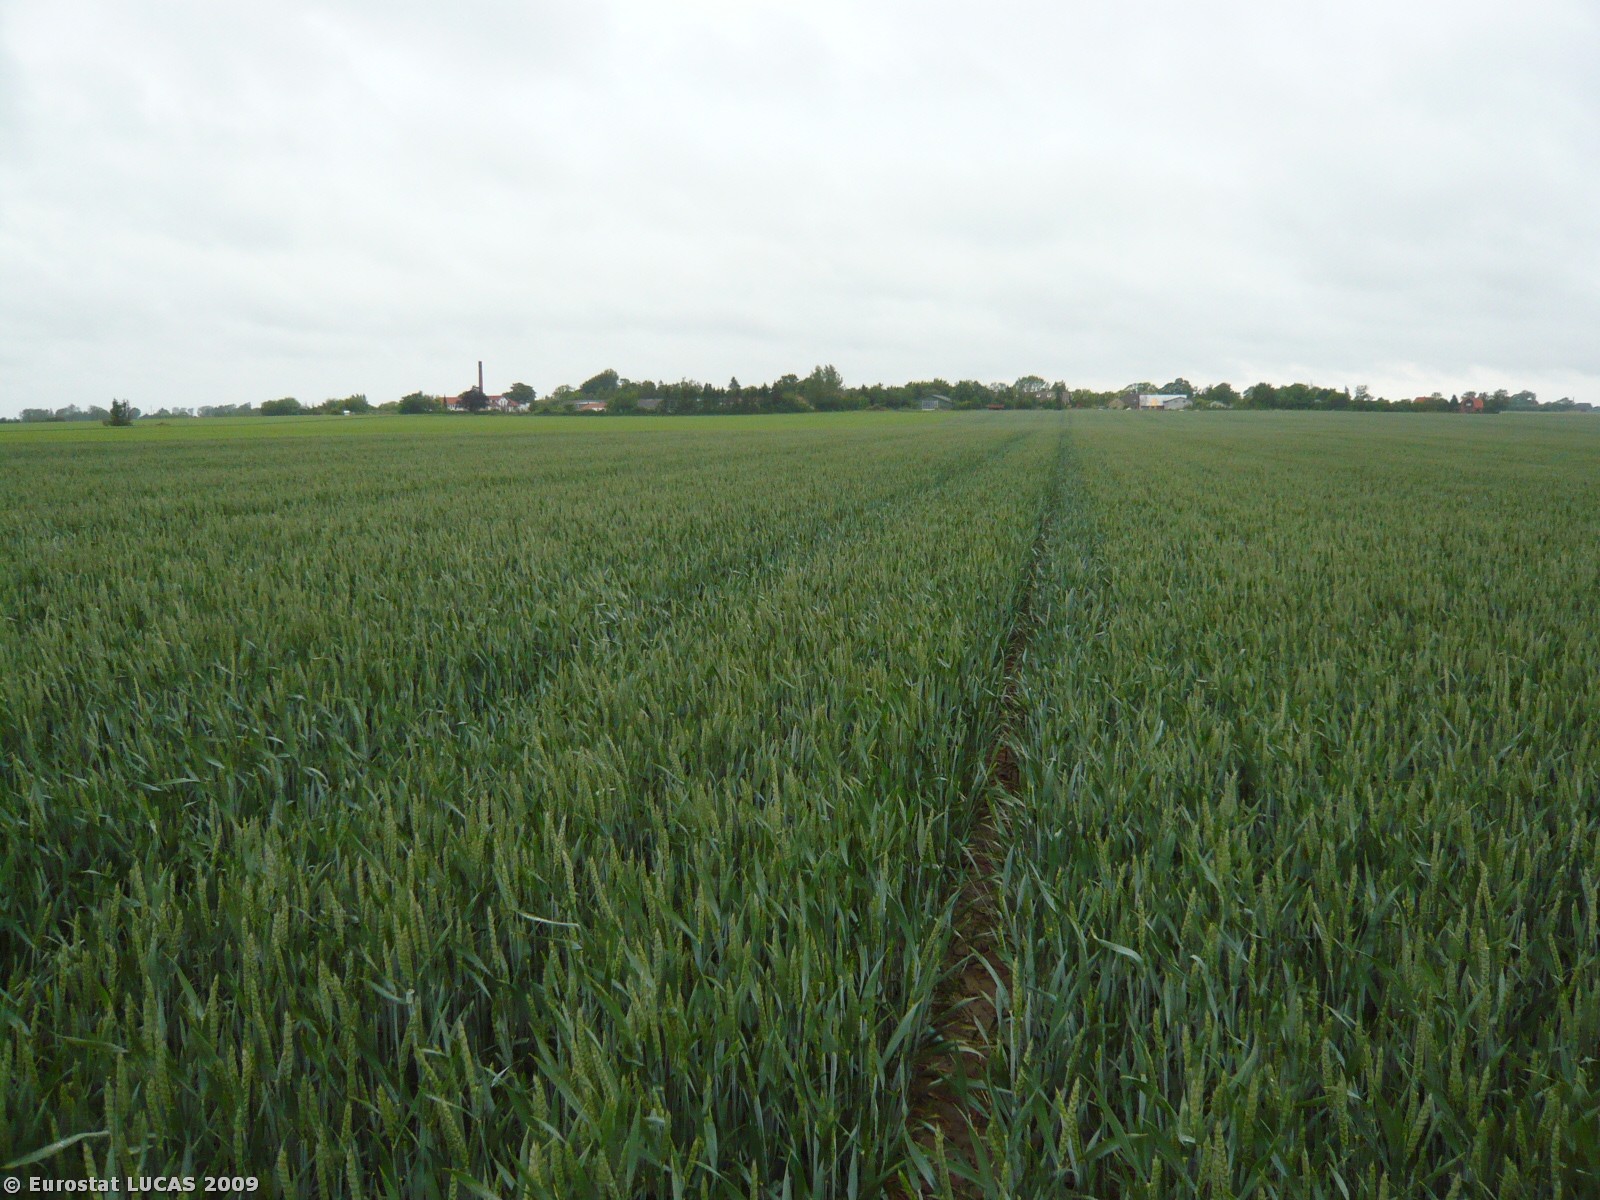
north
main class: Cropland
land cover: Common wheat
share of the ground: > 75 %
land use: Agriculture (excluding fallow land and kitchen gardens)
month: June
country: DK
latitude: 54.8624
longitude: 11.8216
